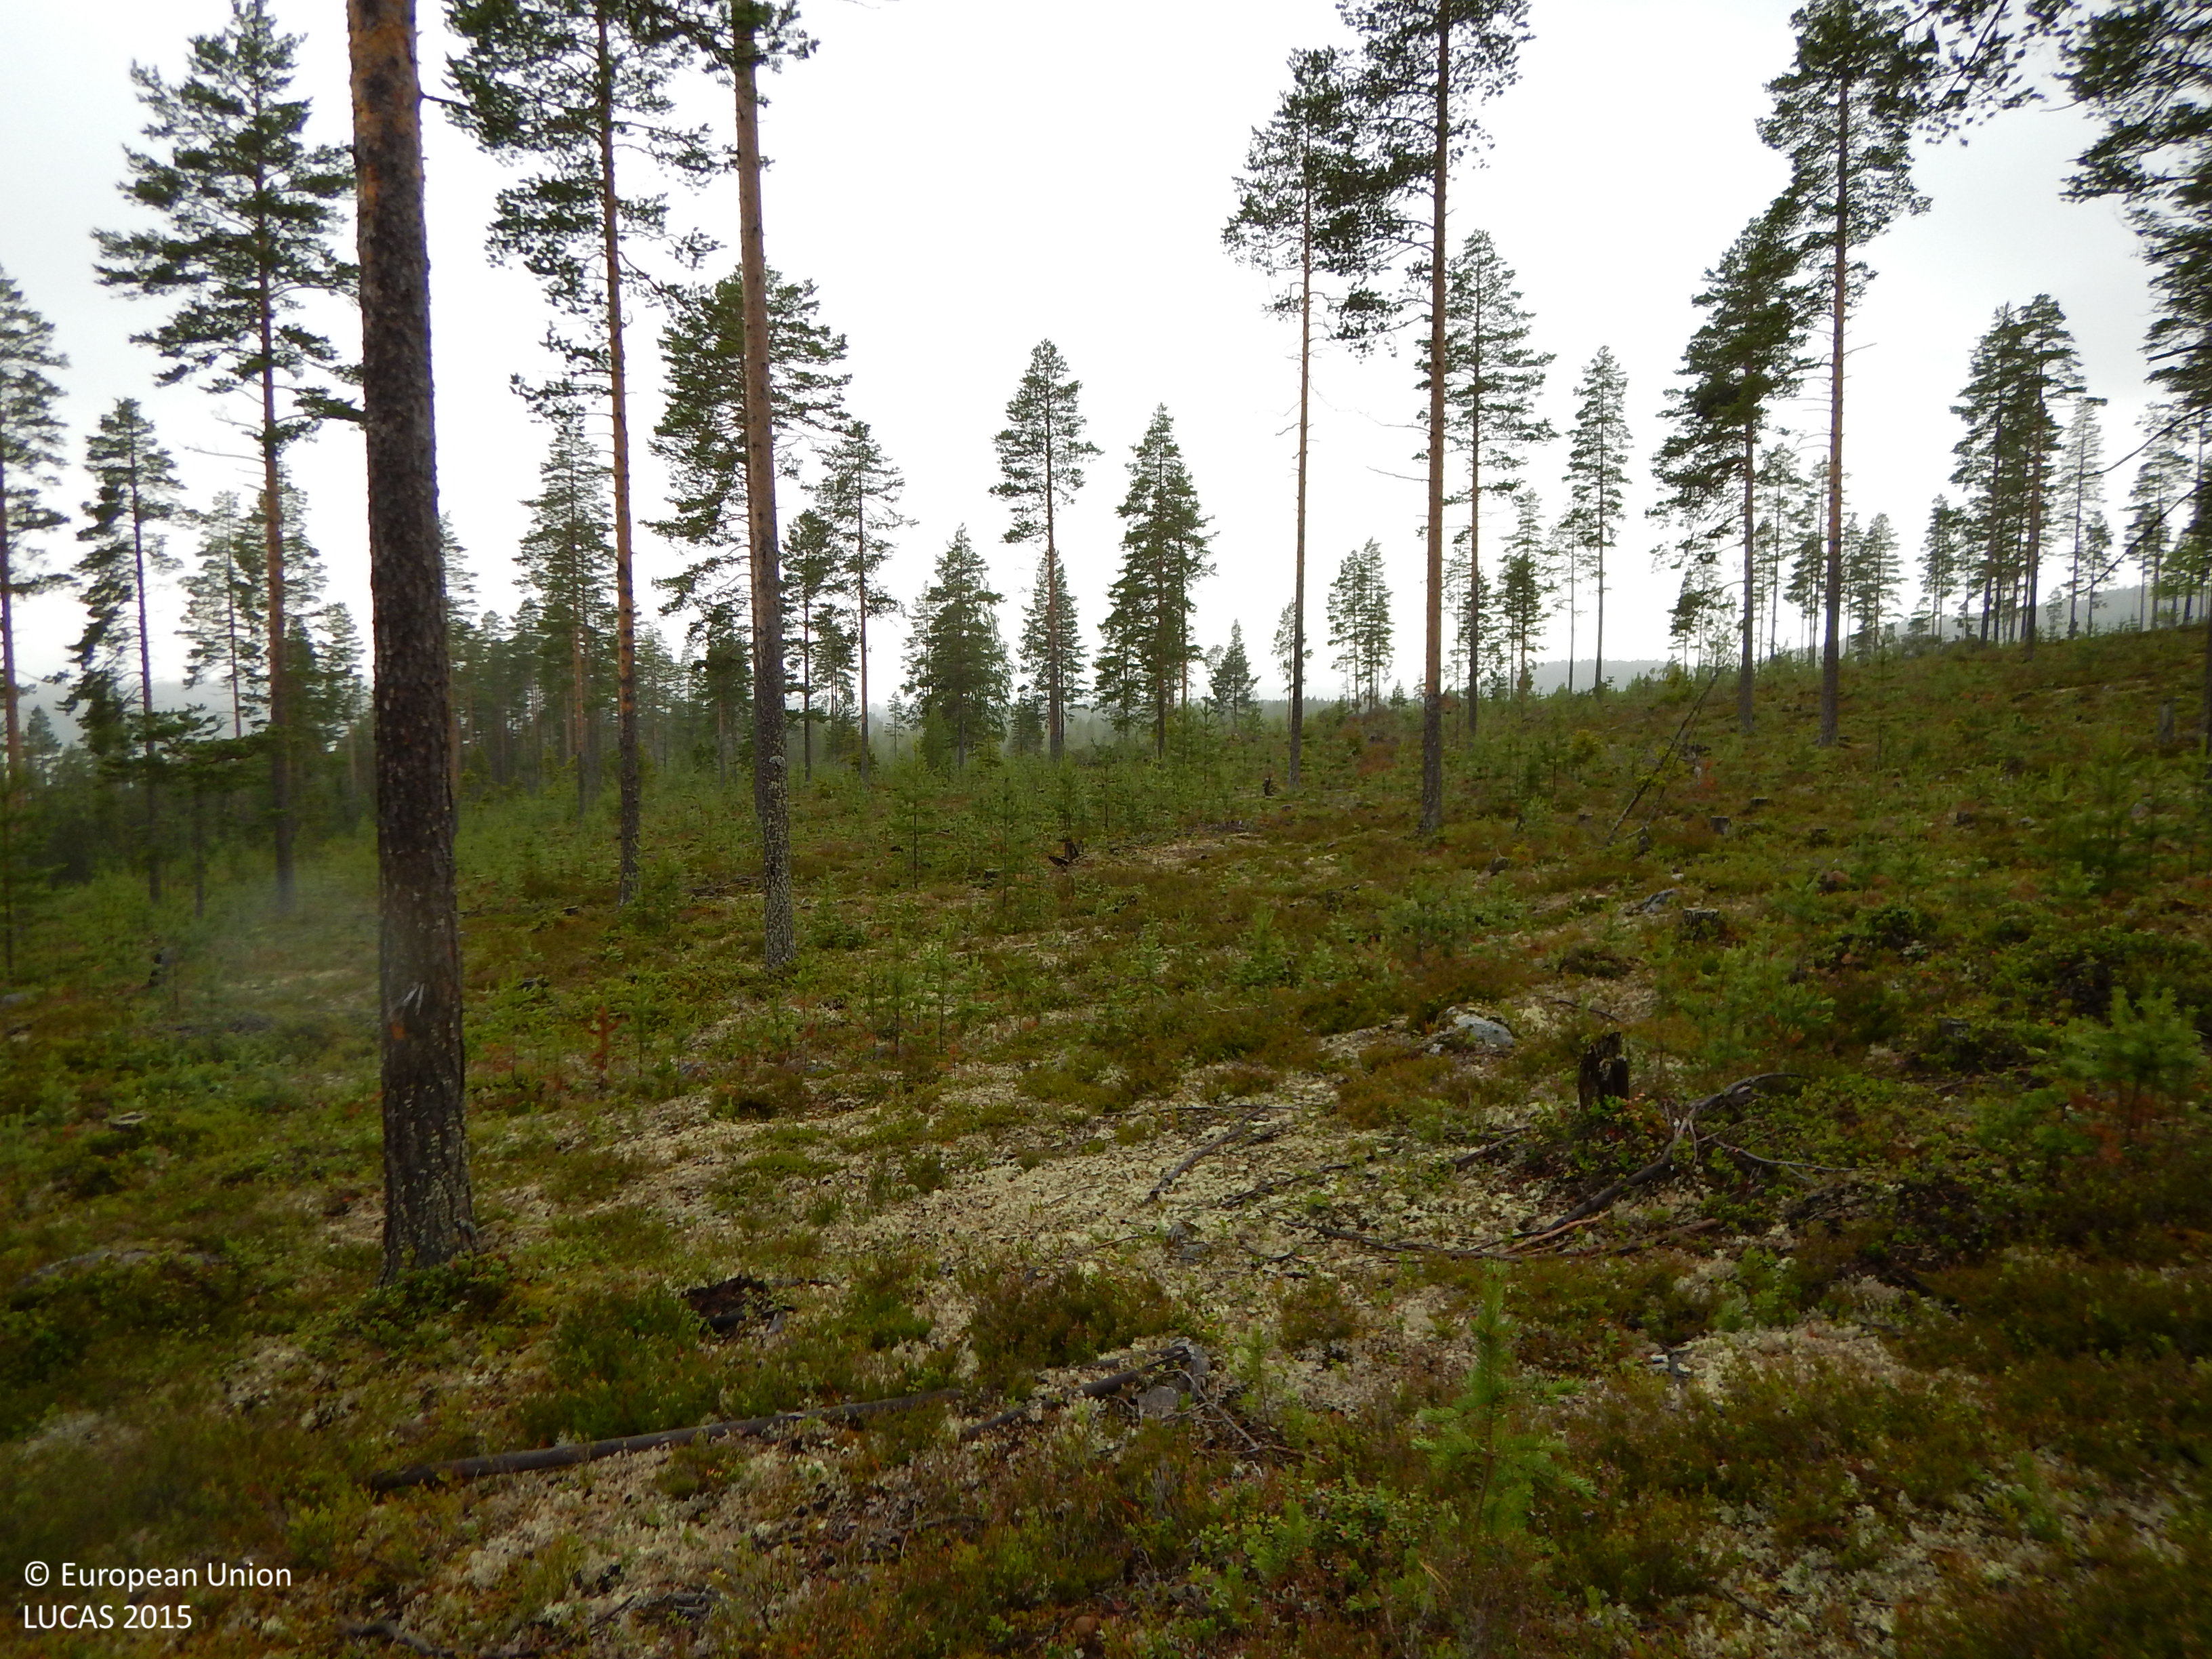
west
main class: Woodland
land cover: Pine dominated coniferous woodland
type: boreal forest
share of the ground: 10 - 25 %
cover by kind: shrubs 25 %, lichens and mosses 25 %, herbaceous plants 20 %, coniferous forest trees 15 %, unconsolidated bare surface 10 %, broadleaved forest trees 5 %
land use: Forestry
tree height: < 5 m
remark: Clear cut
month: July
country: SE
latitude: 64.9425
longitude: 20.2343
